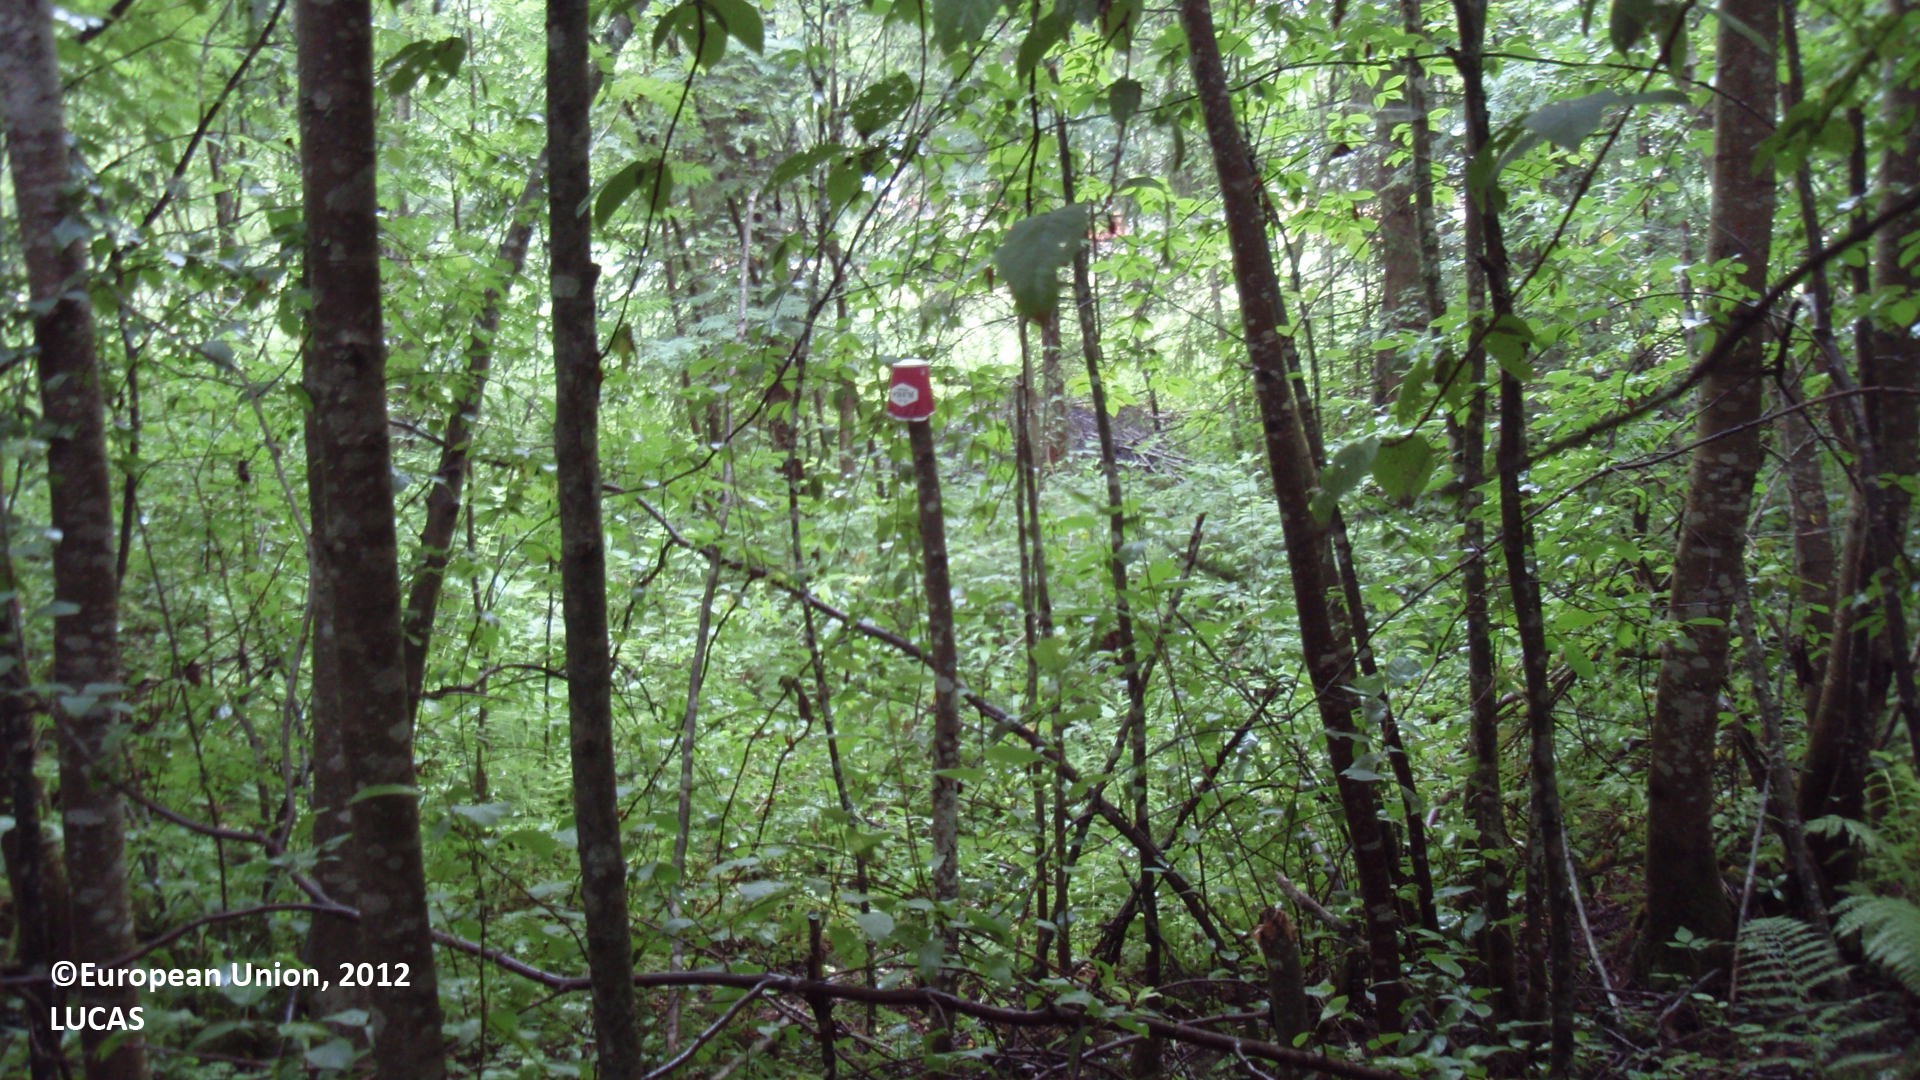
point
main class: Woodland
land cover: Broadleaved woodland
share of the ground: > 75 %
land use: Forestry
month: July
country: FI
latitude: 61.5460
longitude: 27.2723
